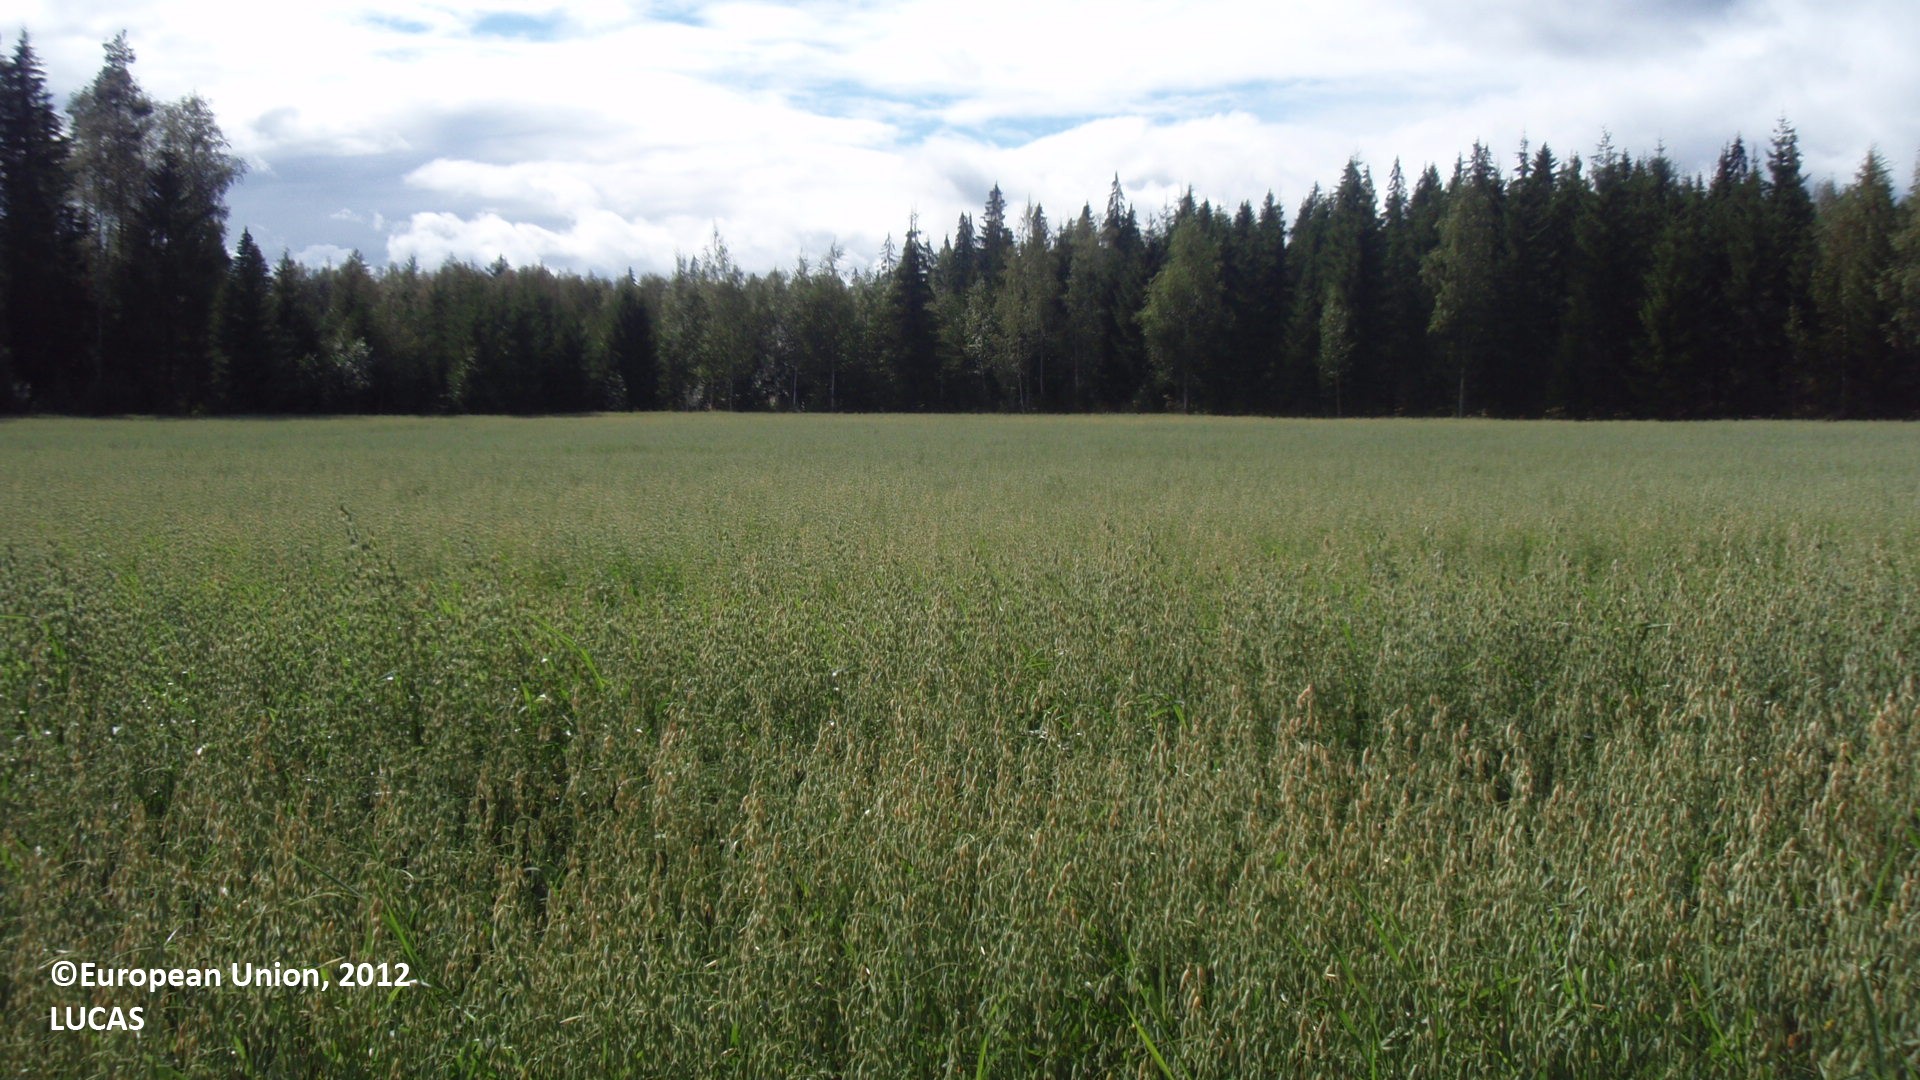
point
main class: Cropland
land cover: Oats
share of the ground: > 75 %
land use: Agriculture (excluding fallow land and kitchen gardens)
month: August
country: FI
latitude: 61.0506
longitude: 27.0775
